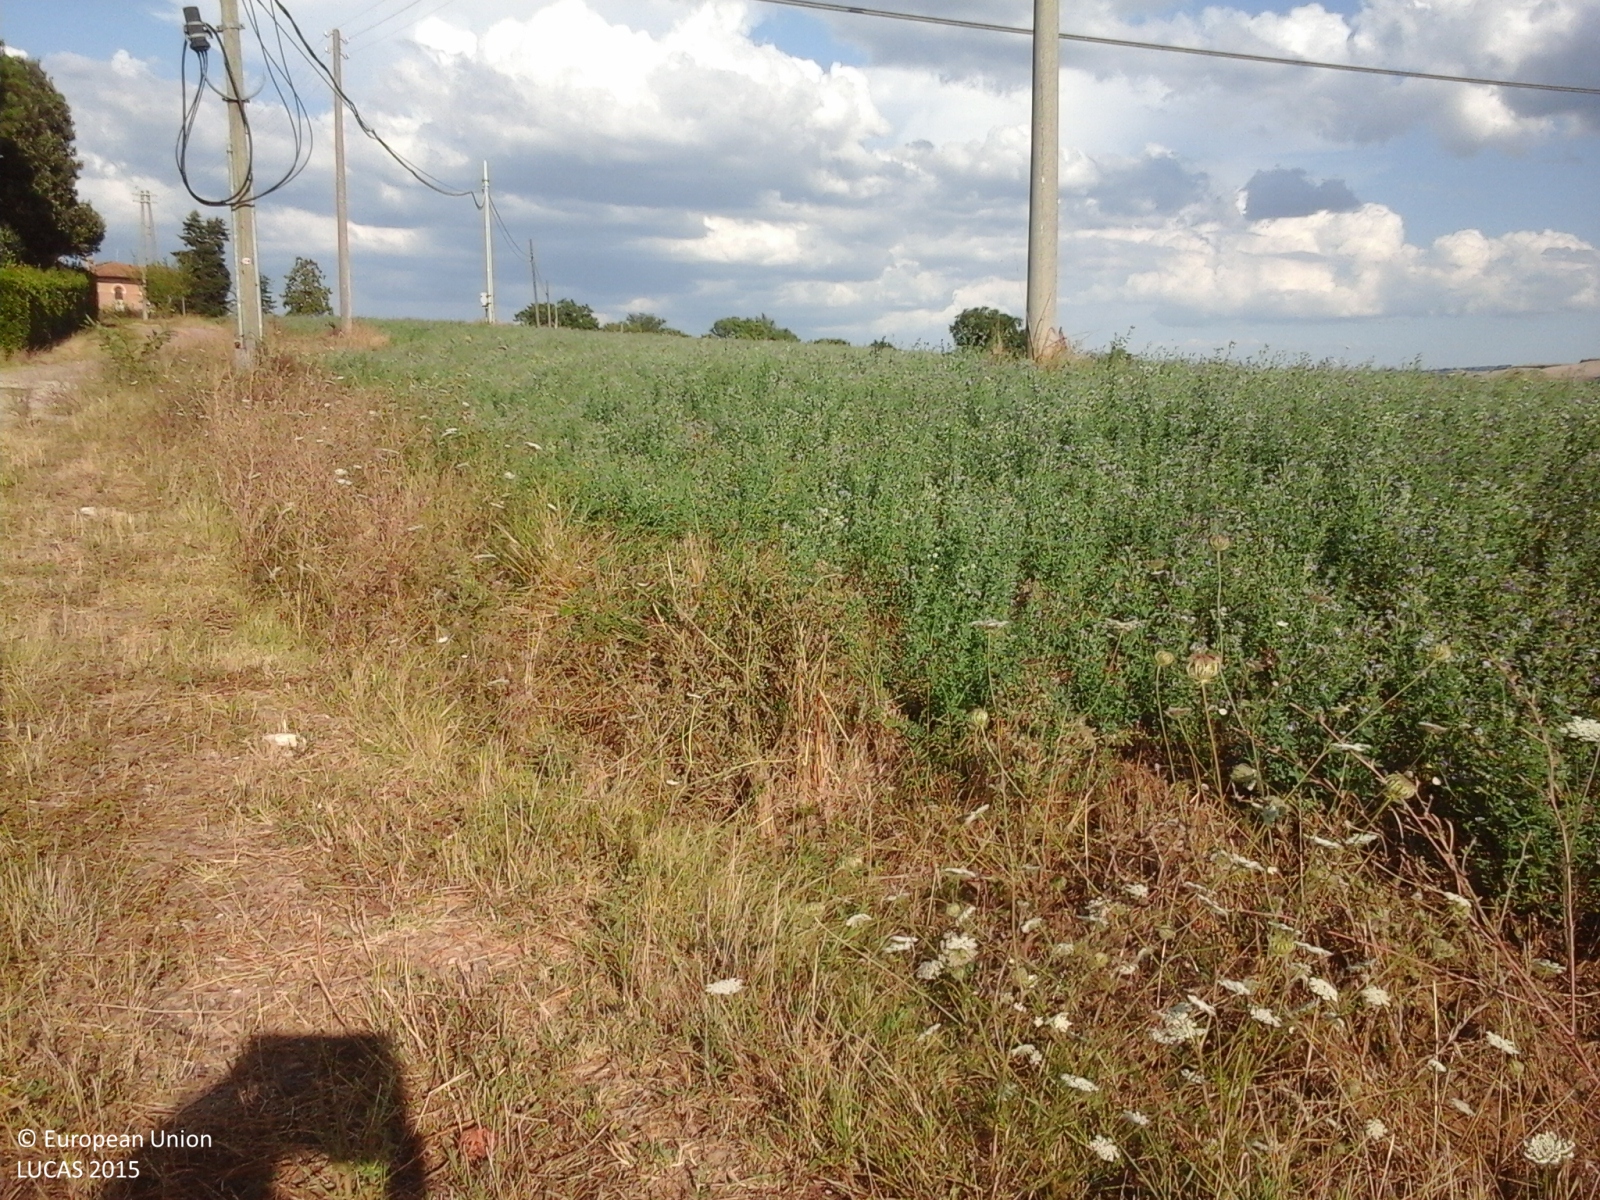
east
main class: Cropland
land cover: Lucerne
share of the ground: > 75 %
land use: Agriculture (excluding fallow land and kitchen gardens)
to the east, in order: Lucerne
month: August
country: IT
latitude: 43.1127
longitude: 11.4825
